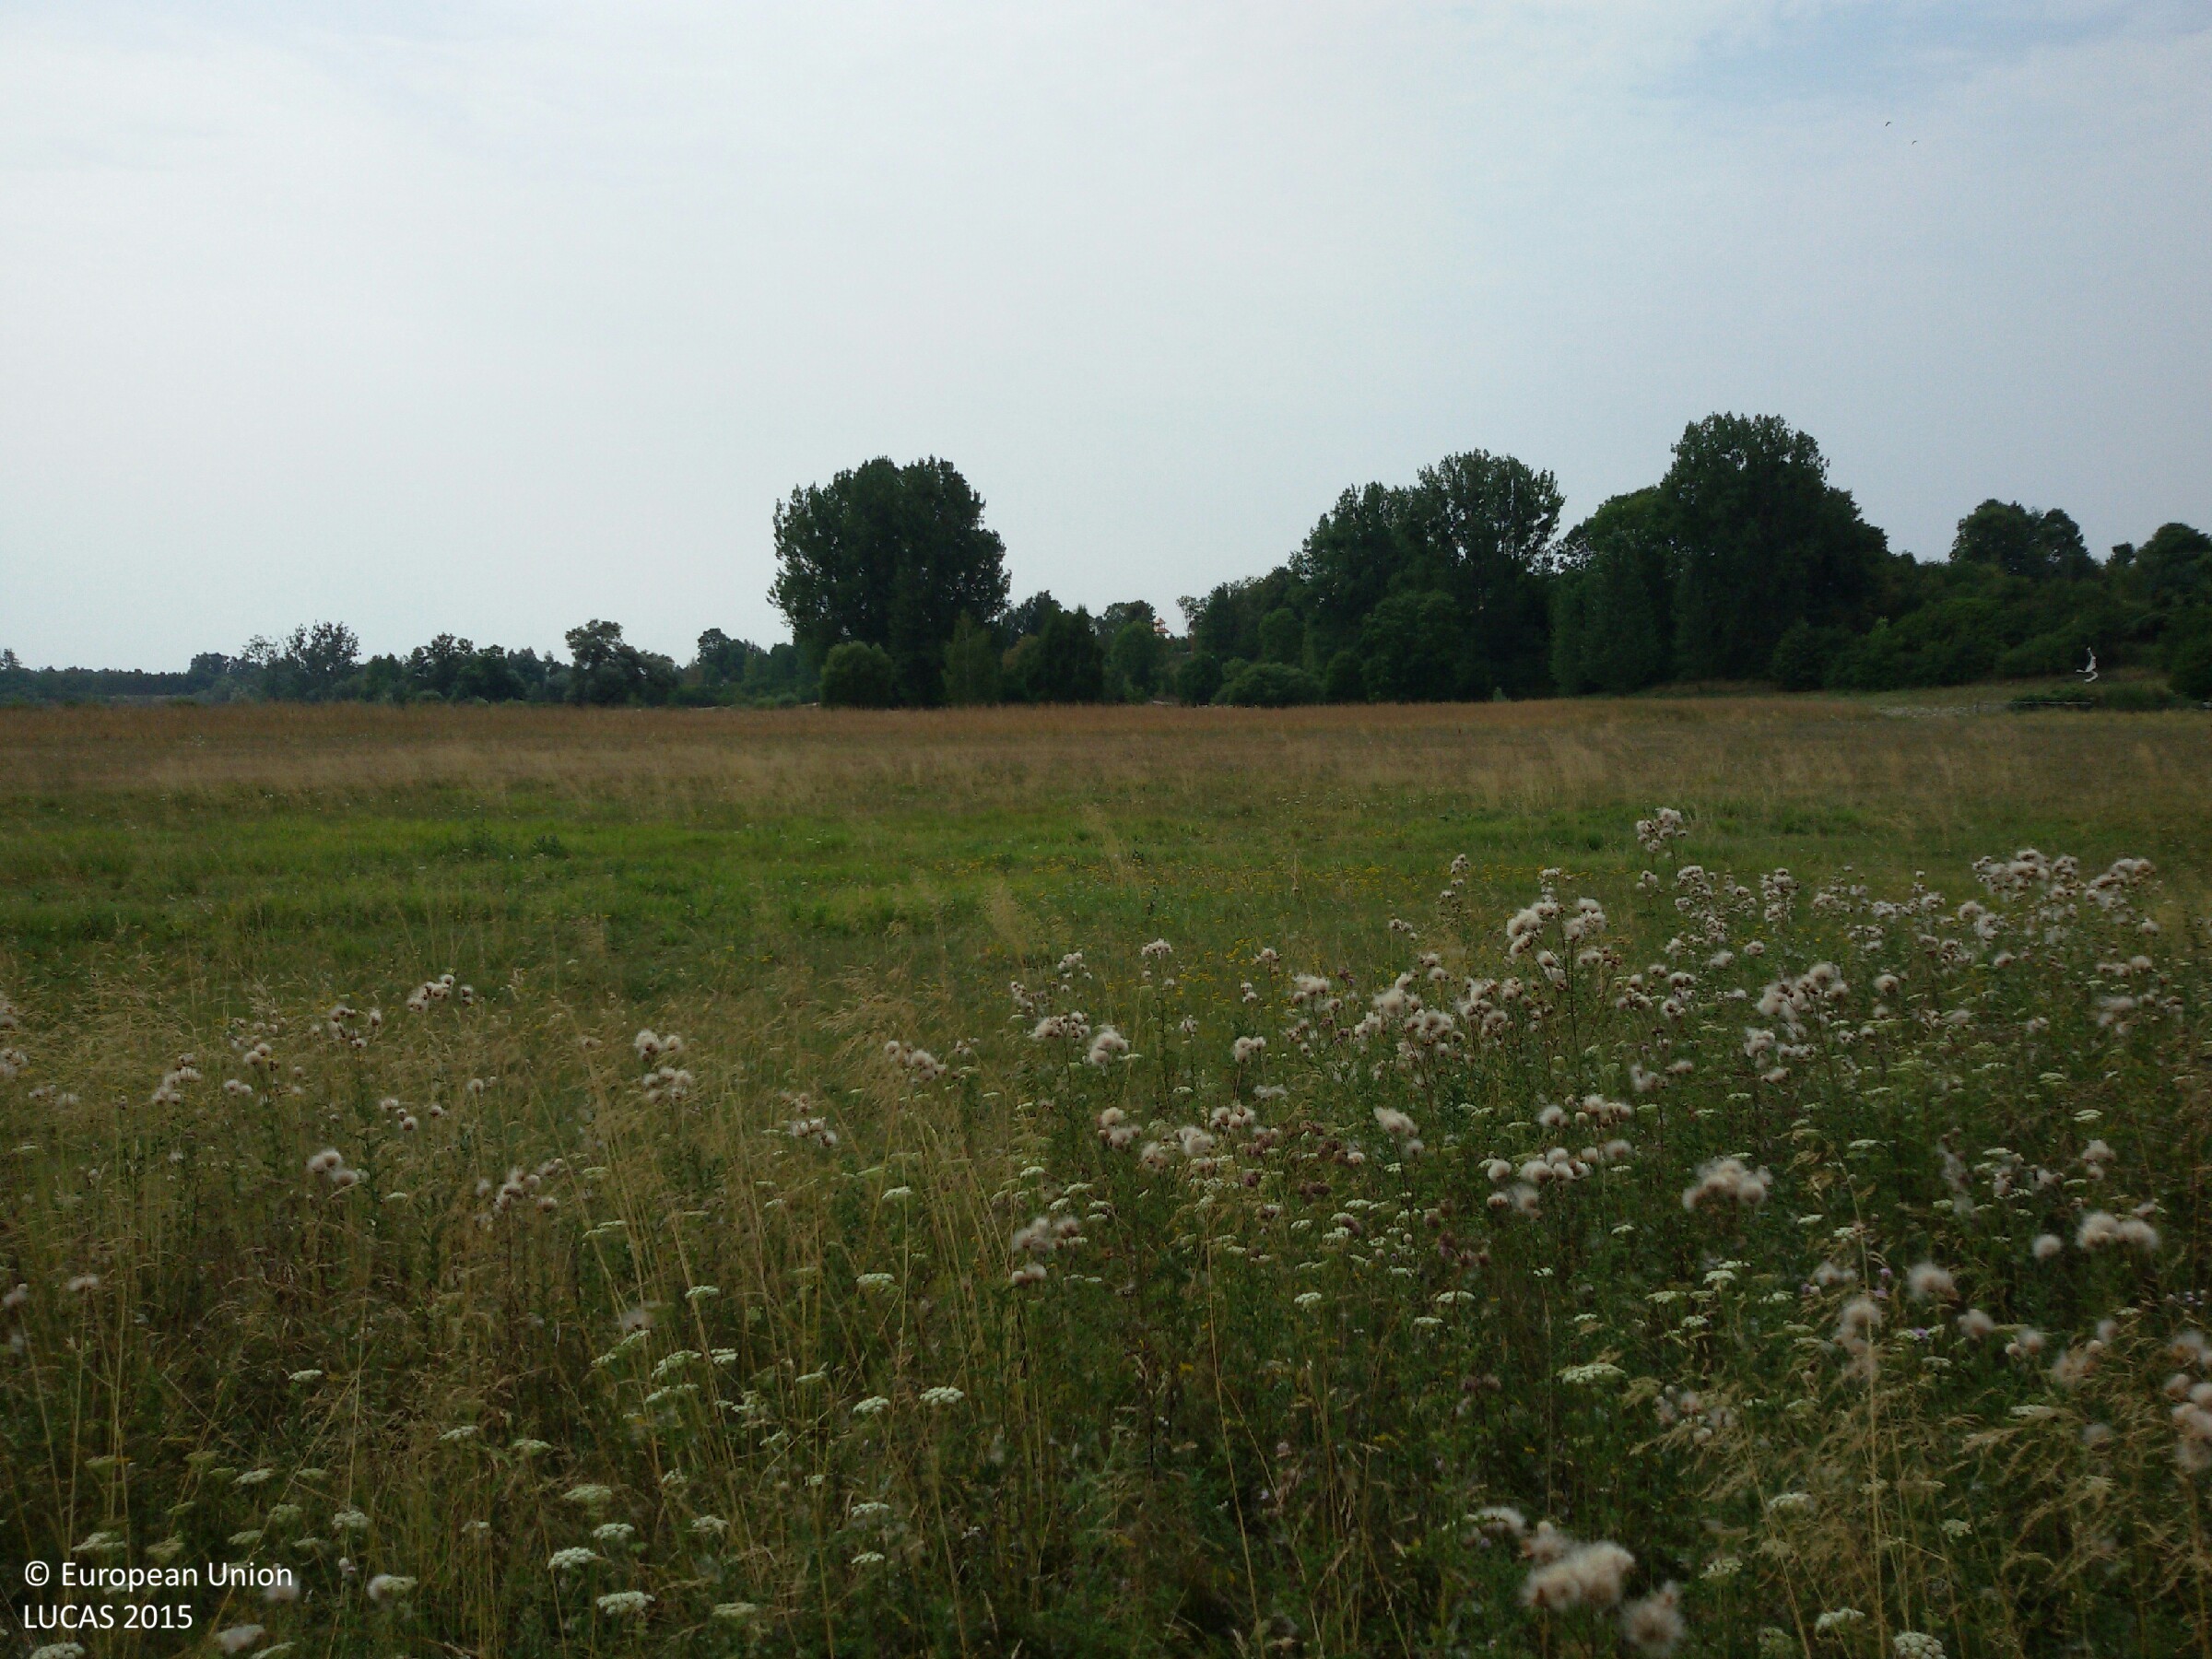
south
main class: Grassland
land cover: Spontaneously vegetated surfaces
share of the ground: > 75 %
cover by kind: herbaceous plants 100 %
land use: Fallow land
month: August
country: PL
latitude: 51.6339
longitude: 23.5363
